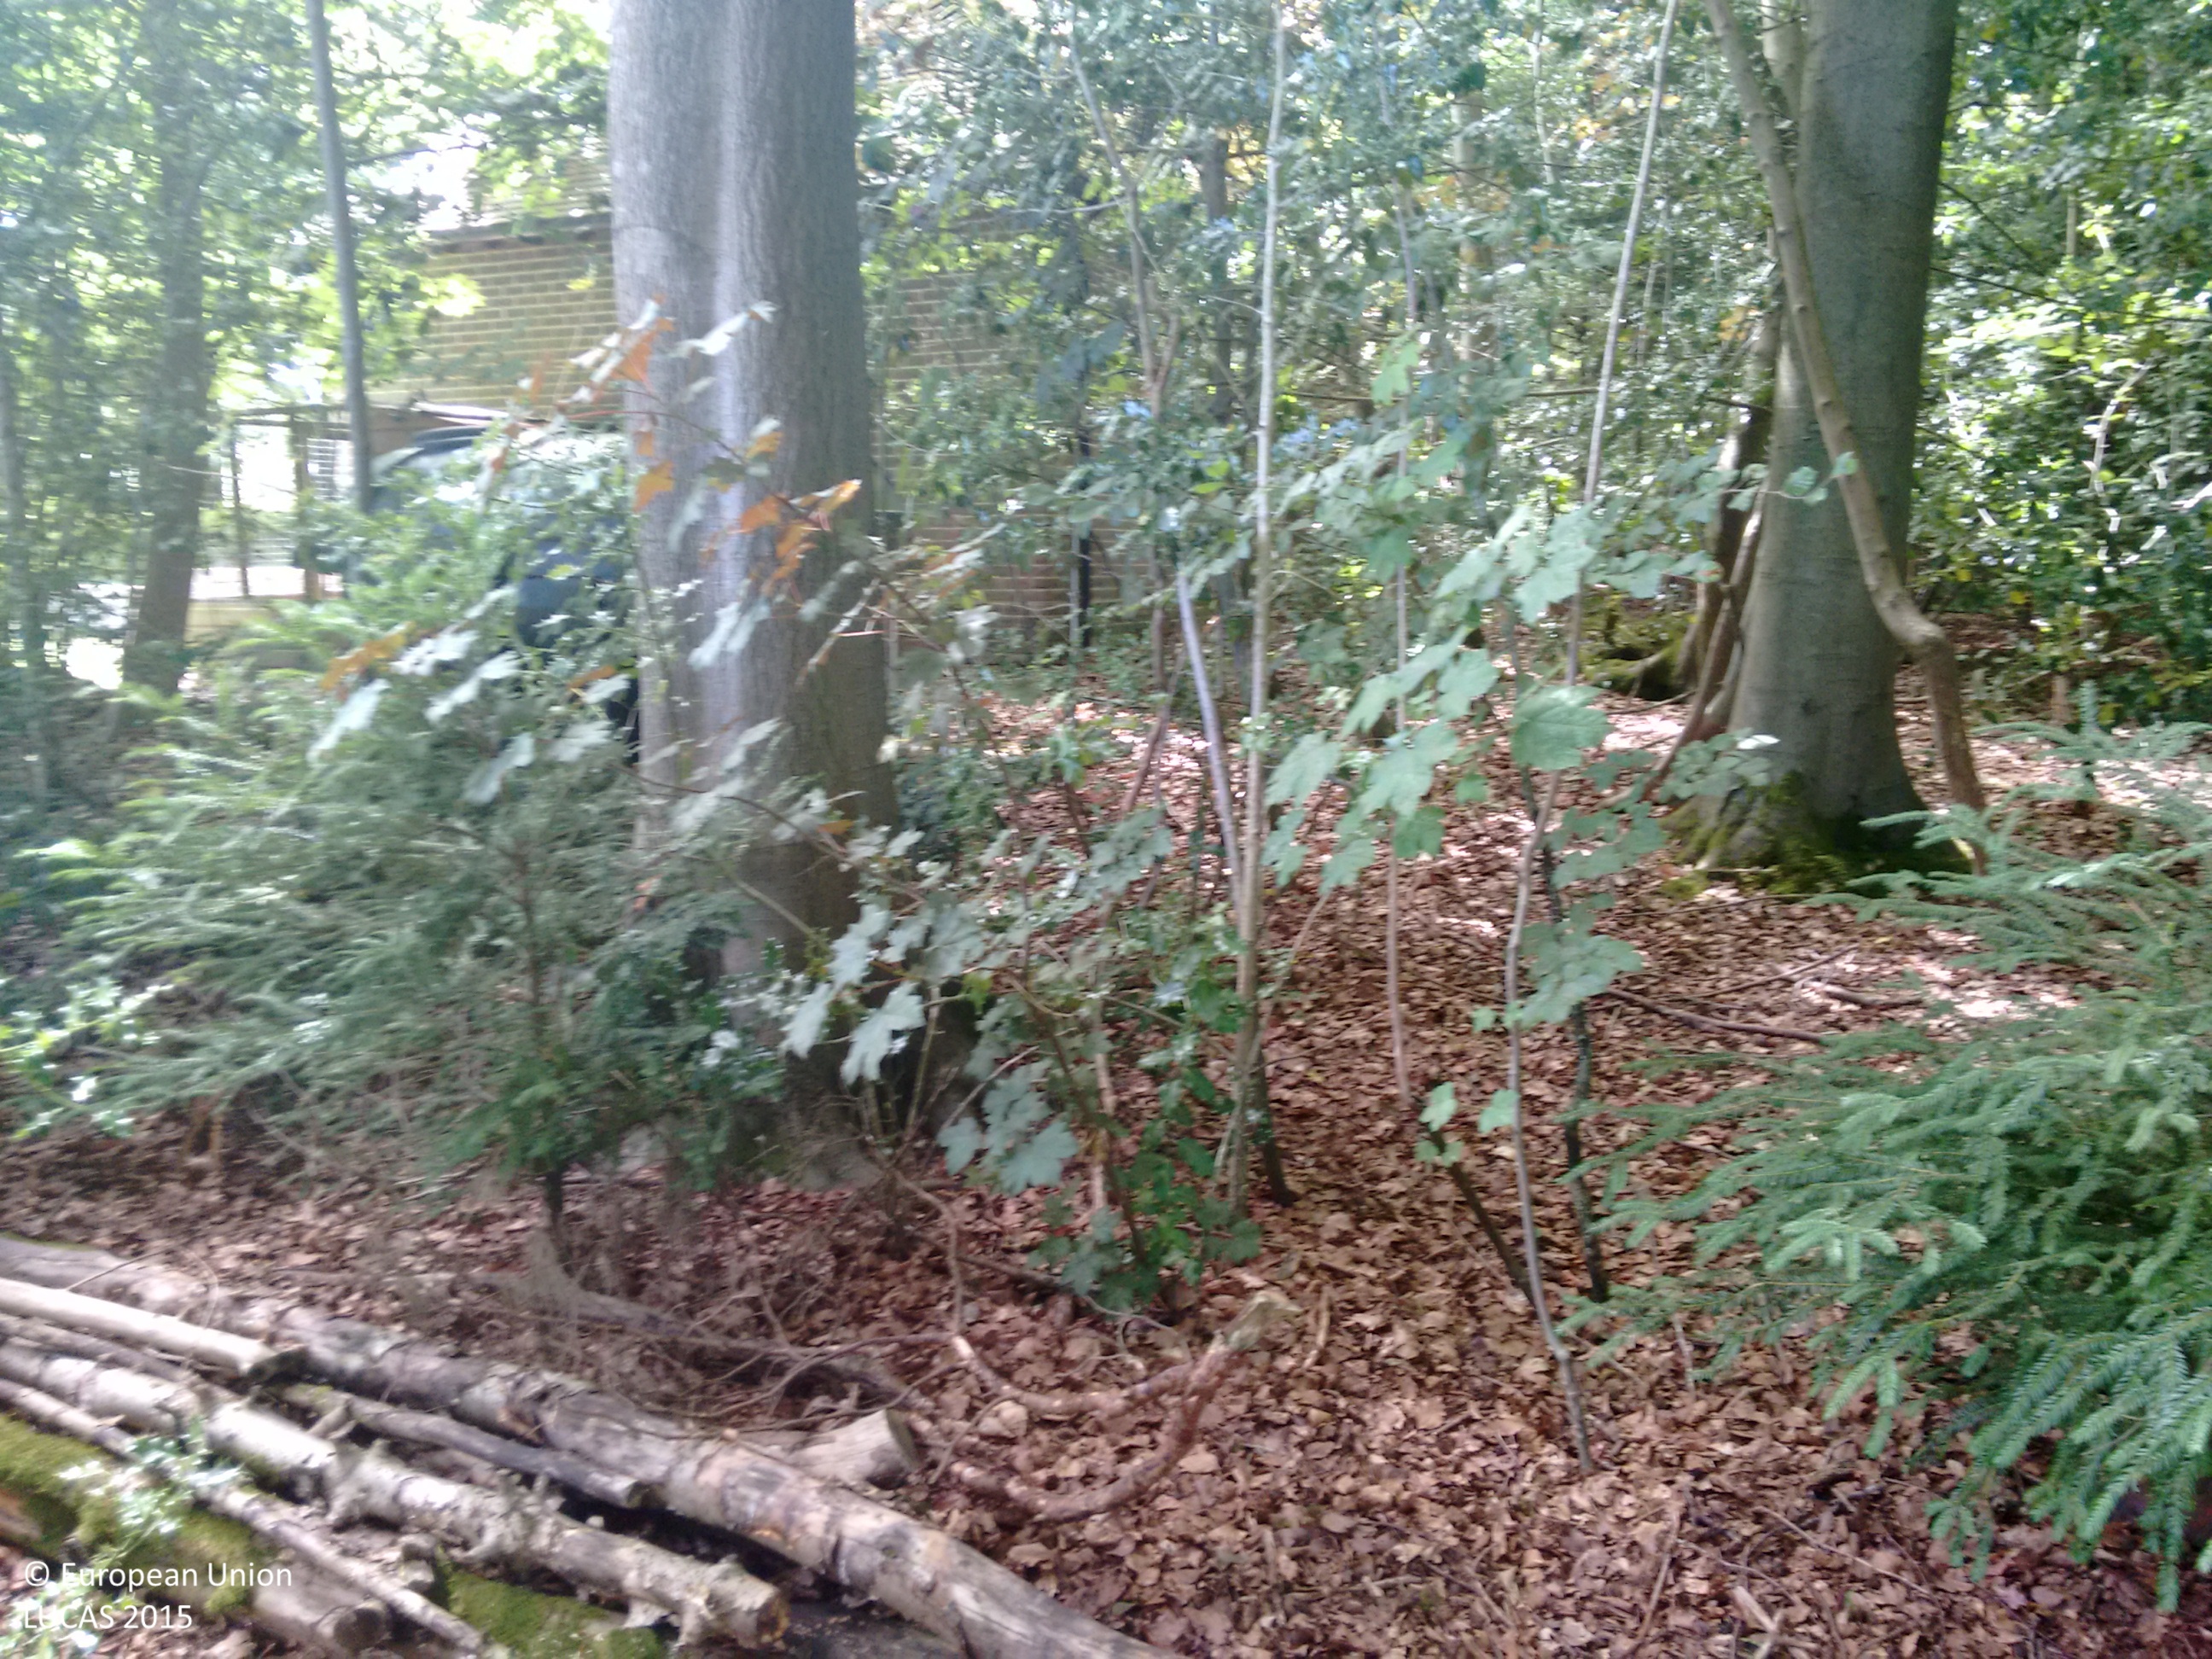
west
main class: Woodland
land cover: Broadleaved woodland
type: beech forest
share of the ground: > 75 %
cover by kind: broadleaved forest trees 100 %
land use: Residential
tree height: > 5 m
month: July
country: GB
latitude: 50.9836
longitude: -0.9119
